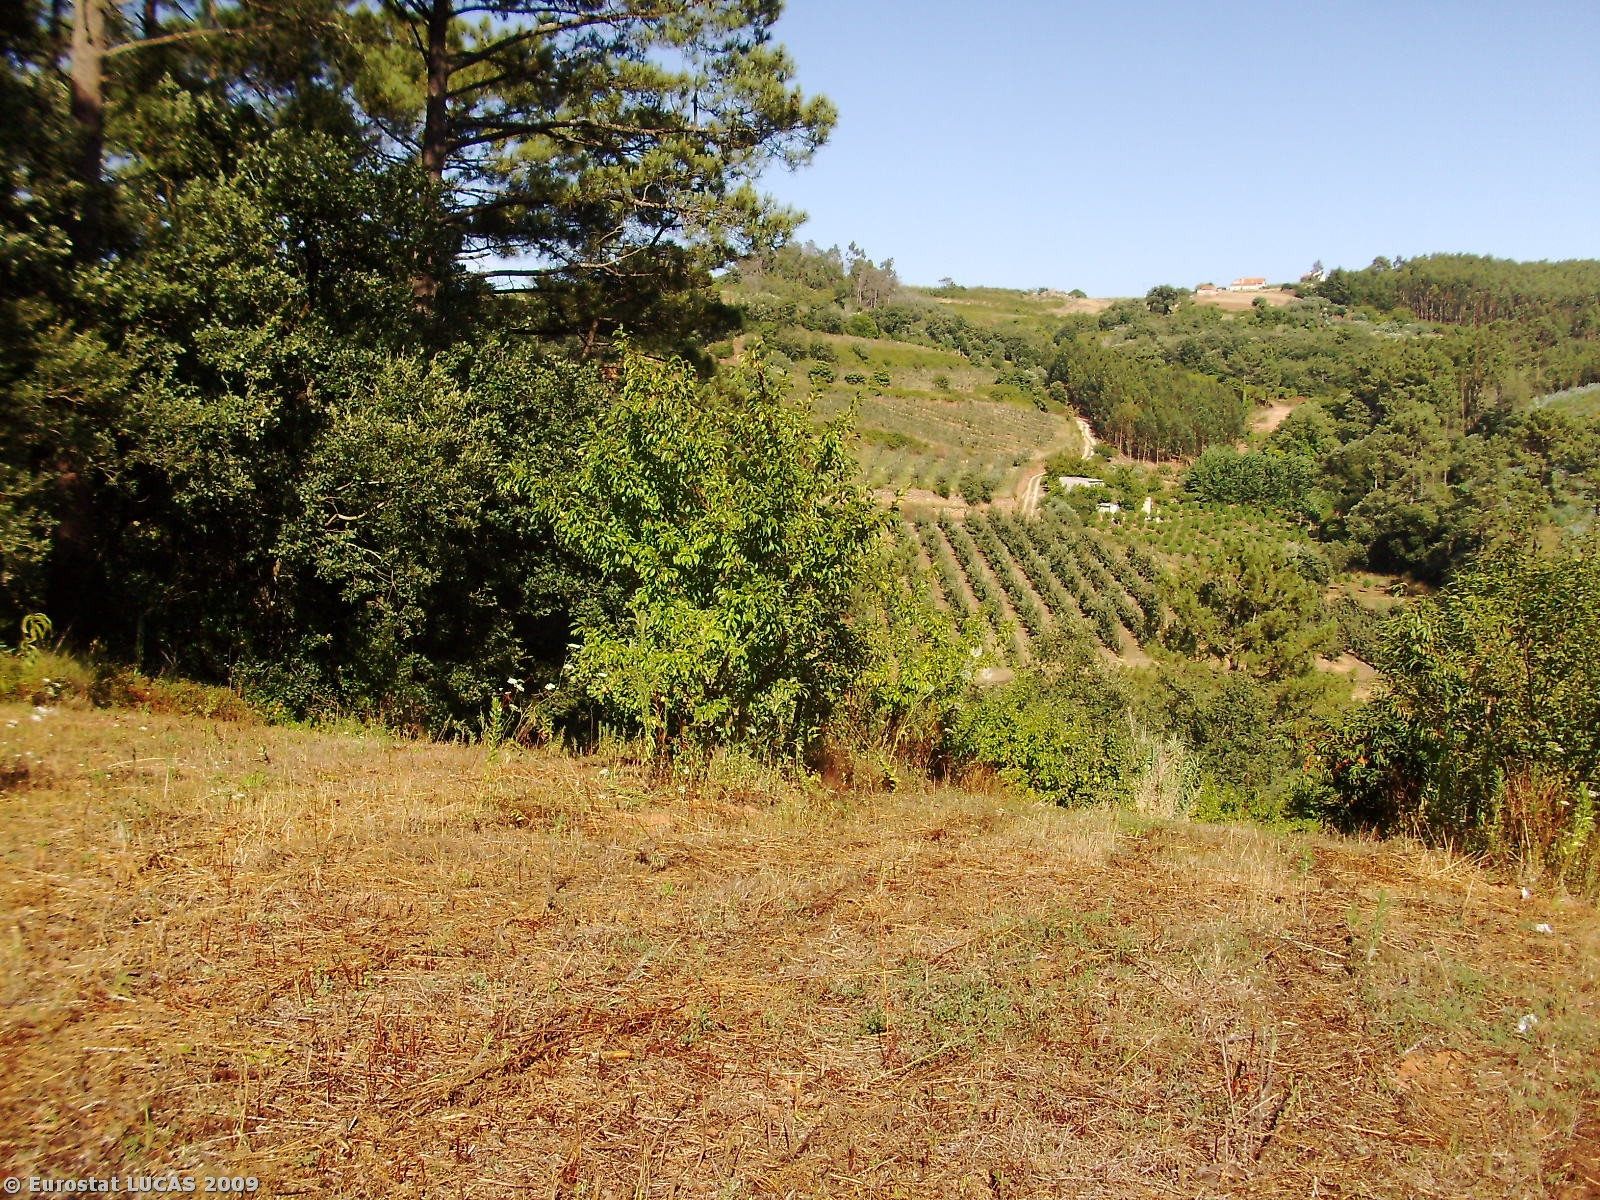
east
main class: Grassland
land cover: Spontaneously vegetated surfaces
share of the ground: > 75 %
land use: Fallow land
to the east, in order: Spontaneously vegetated surfaces; Single bushes/trees; Spontaneously vegetated surfaces; Dry stone walls; Broadleaved woodland; Coniferous woodland; Shrubland with sparse tree cover; Rivers and streams; Apple fruit; Dry stone walls; Apple fruit
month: July
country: PT
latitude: 39.5057
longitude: -8.9850
